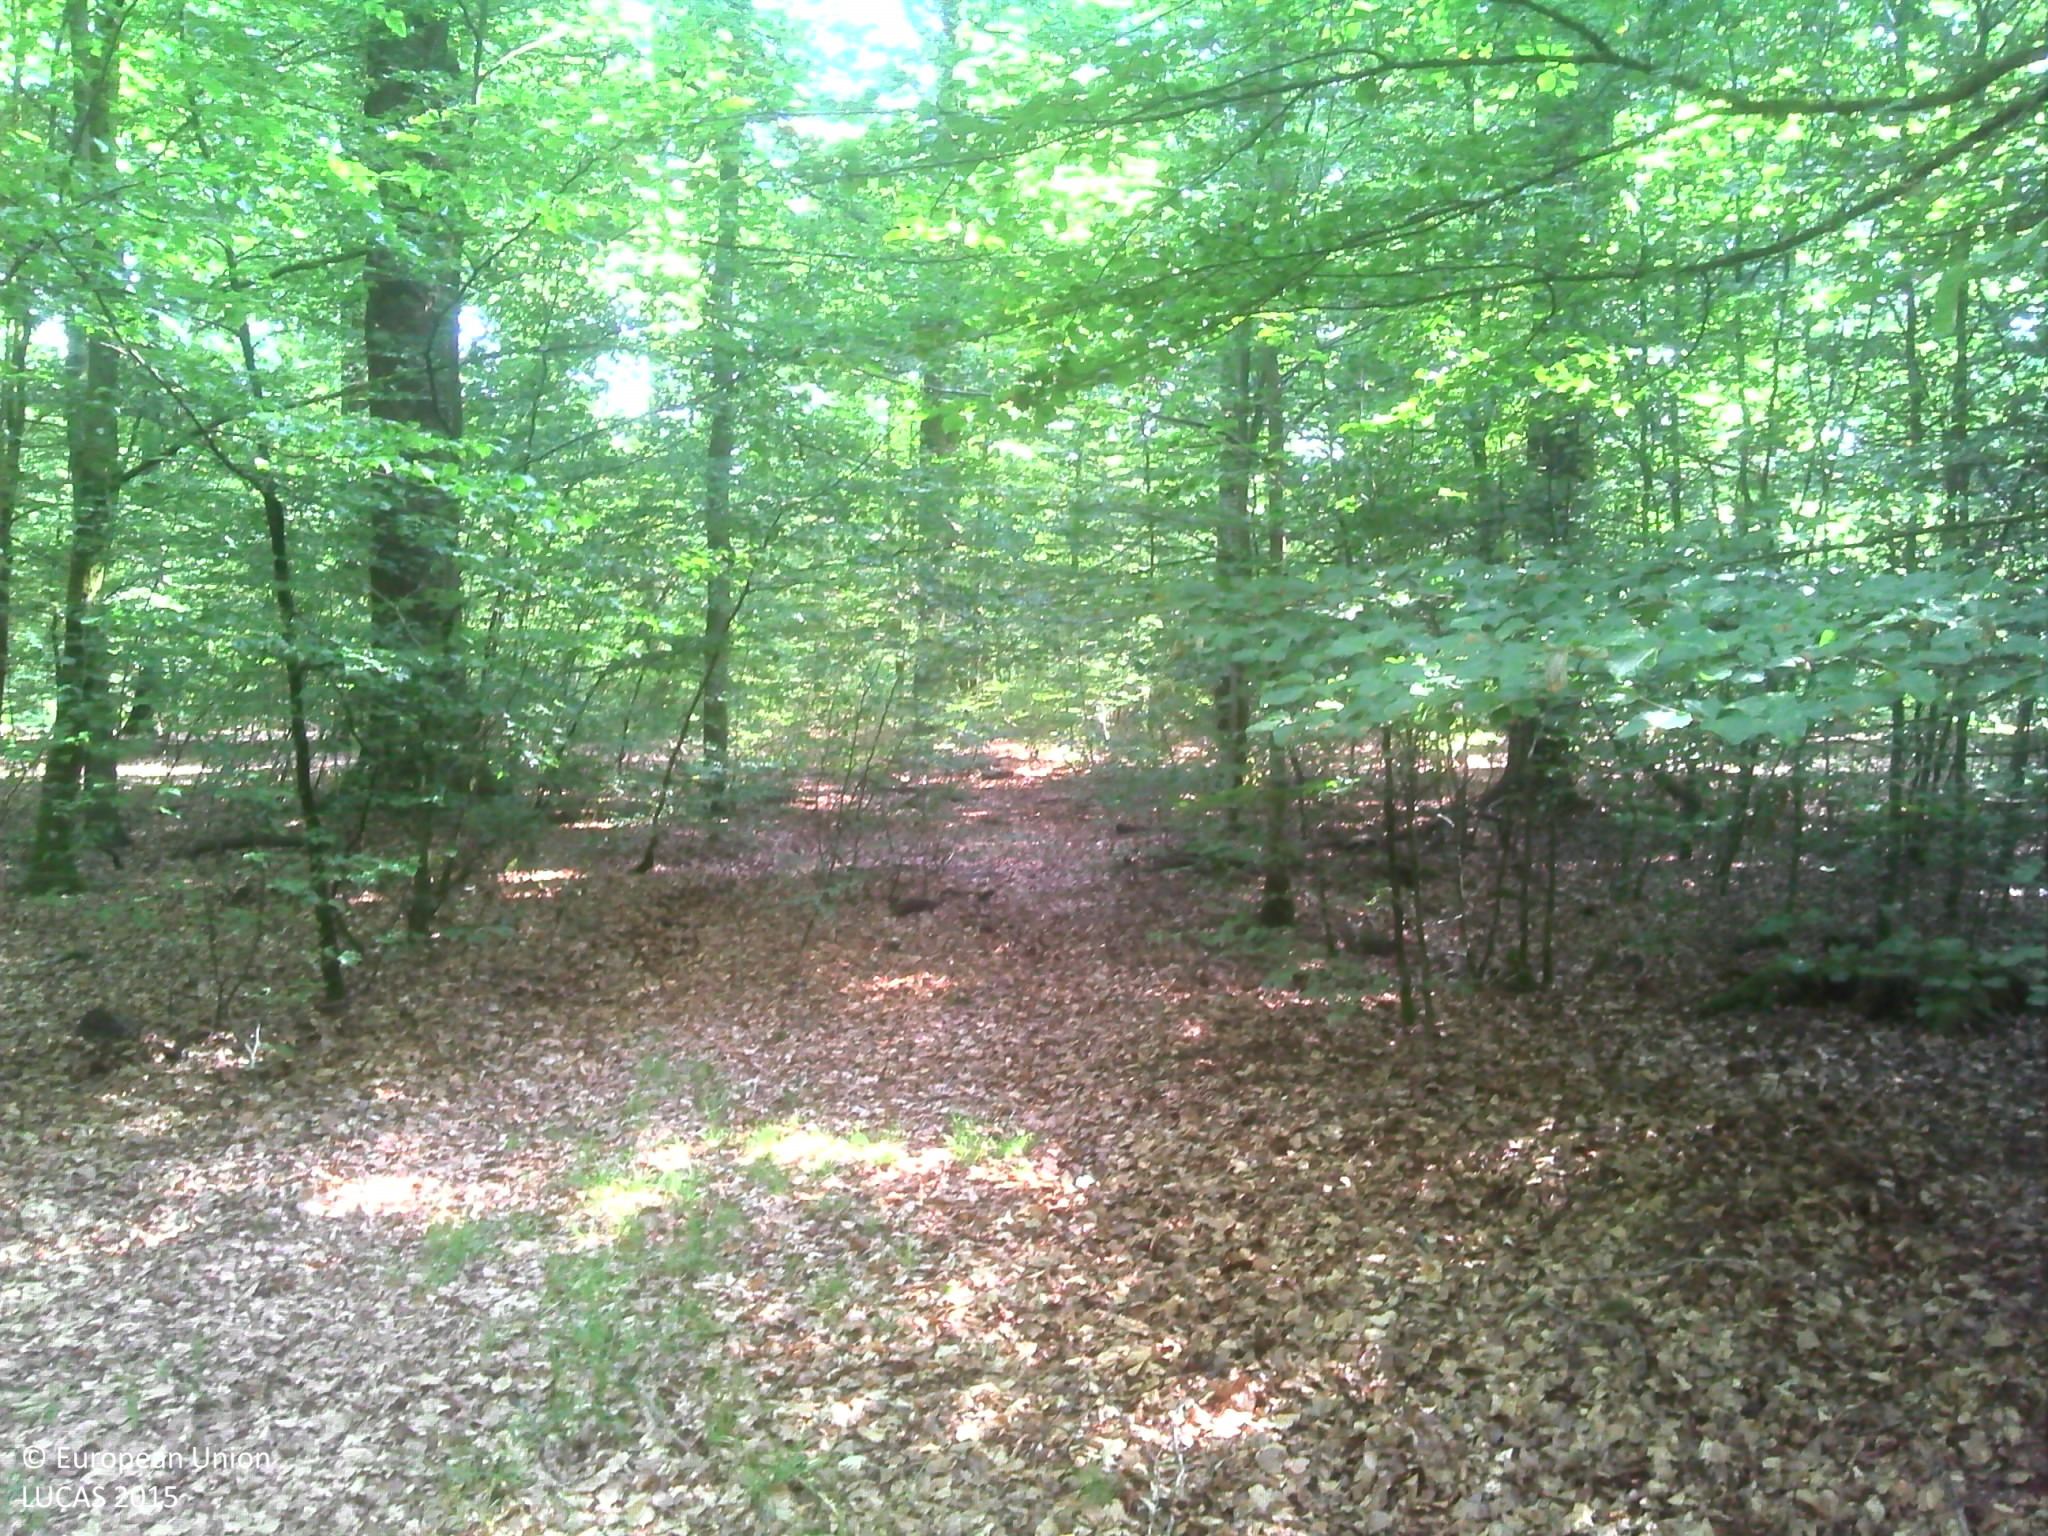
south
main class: Woodland
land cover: Broadleaved woodland
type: beech forest
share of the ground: > 75 %
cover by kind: broadleaved forest trees 80 %, shrubs 10 %, herbaceous plants 5 %, unconsolidated bare surface 5 %
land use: Forestry
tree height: > 5 m
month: July
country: BE
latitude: 49.8141
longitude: 5.6766
